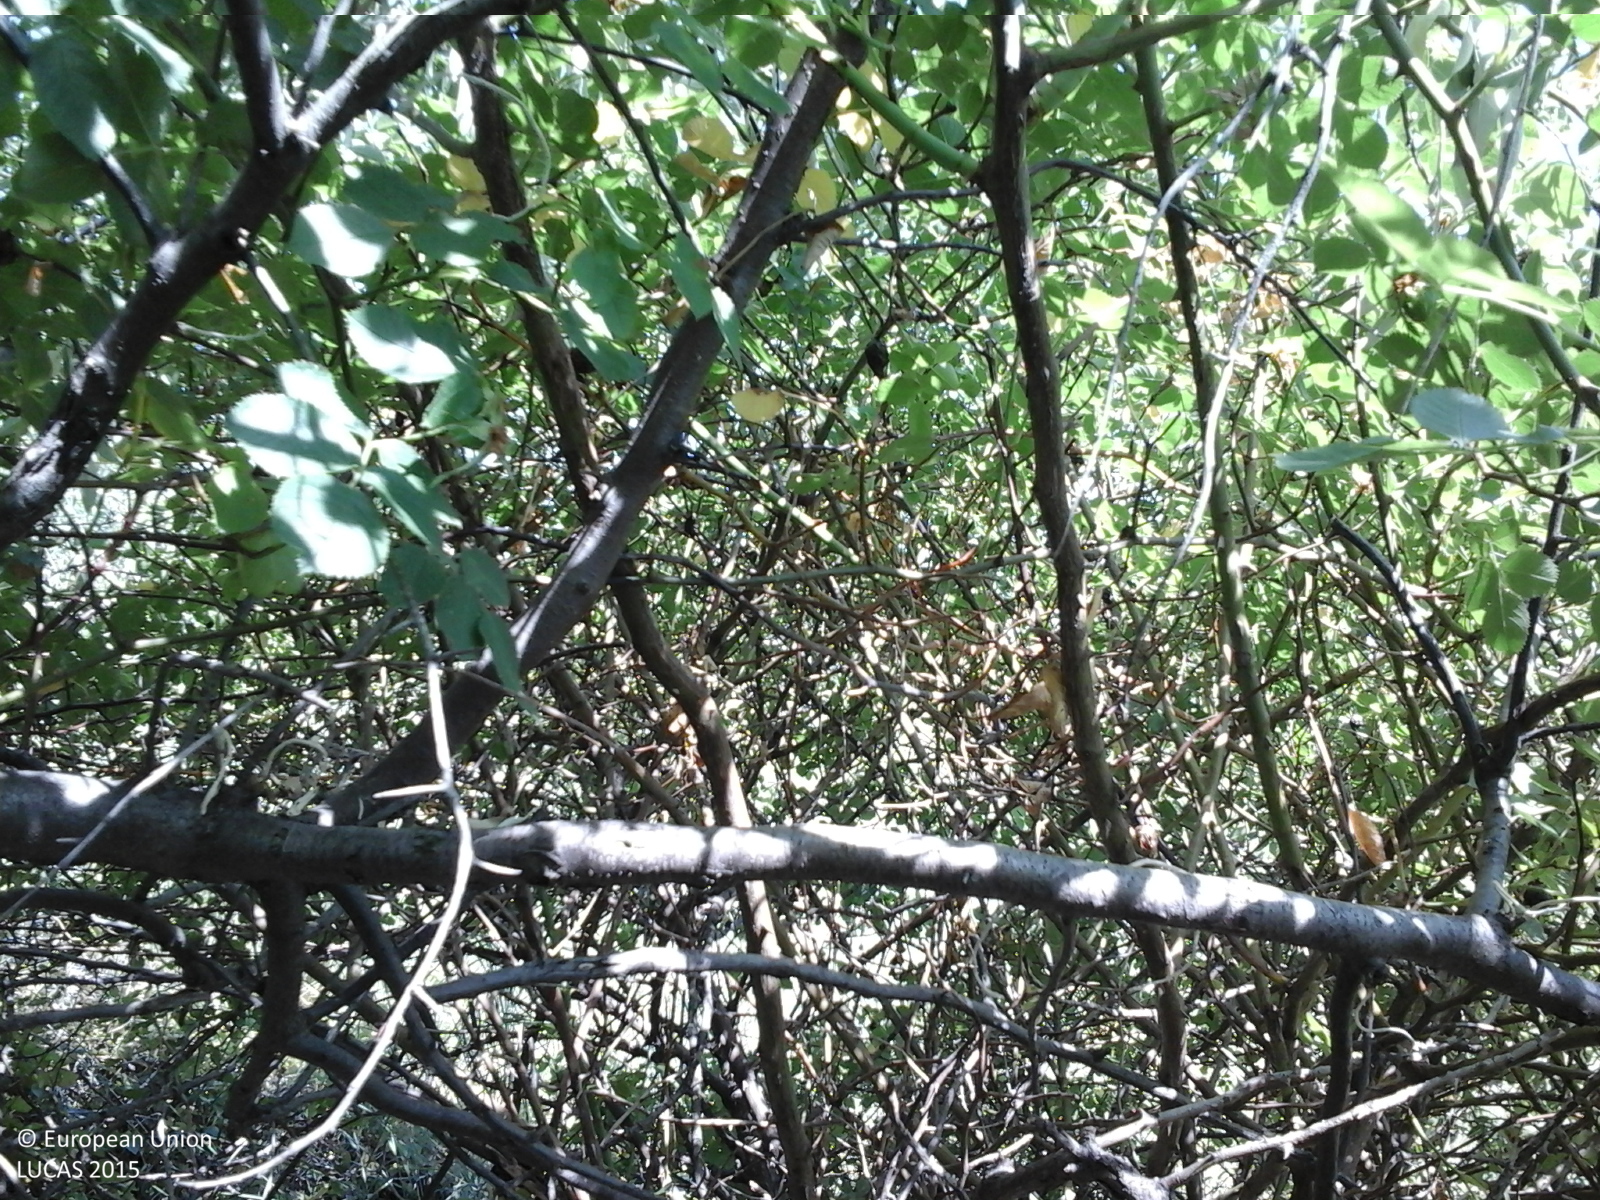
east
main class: Shrubland
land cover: Shrubland with sparse tree cover
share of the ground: > 75 %
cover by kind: shrubs 80 %, herbaceous plants 15 %, broadleaved forest trees 5 %
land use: Agriculture (excluding fallow land and kitchen gardens)
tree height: > 5 m
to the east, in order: Shrubland with sparse tree cover; Grassland with sparse tree/shrub cover; Maize; Vineyards; Maize; Lucerne; Maize; Sunflower
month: June
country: RO
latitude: 47.5141
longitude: 27.0073
